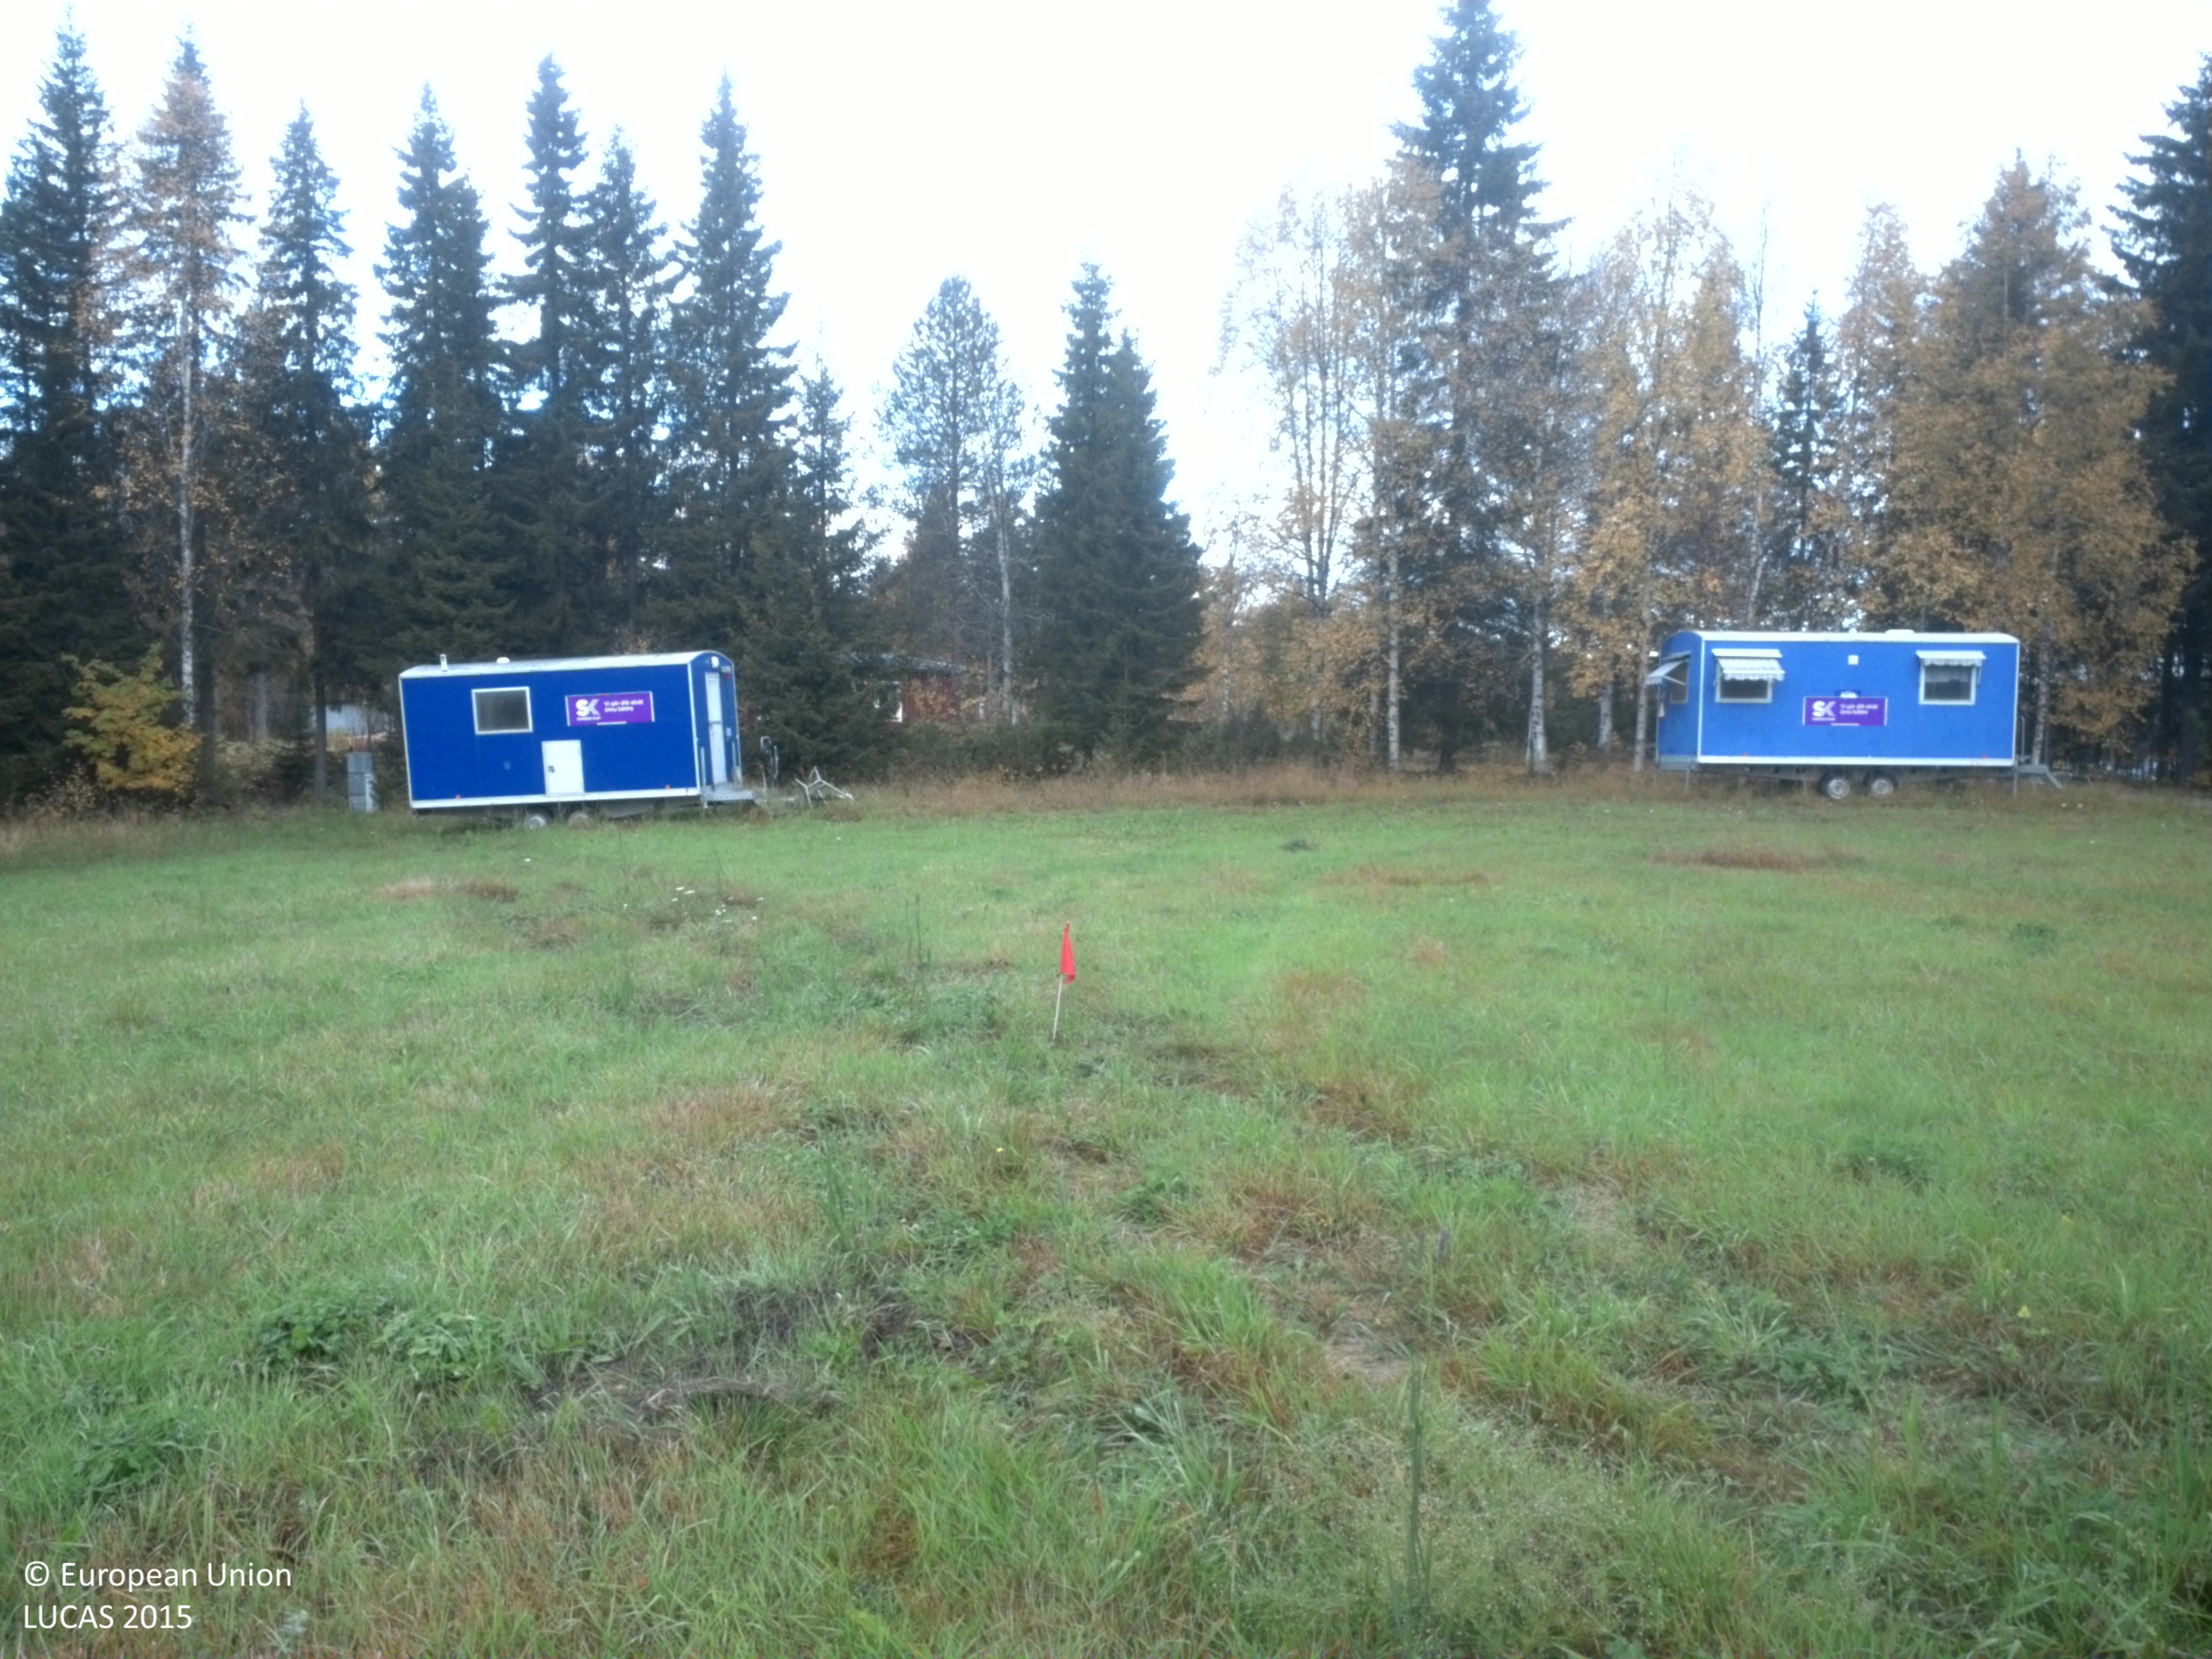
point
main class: Grassland
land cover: Grassland without tree/shrub cover
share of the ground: > 75 %
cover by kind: herbaceous plants 100 %
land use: Agriculture (excluding fallow land and kitchen gardens)
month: September
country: SE
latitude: 64.2293
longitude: 19.9746
